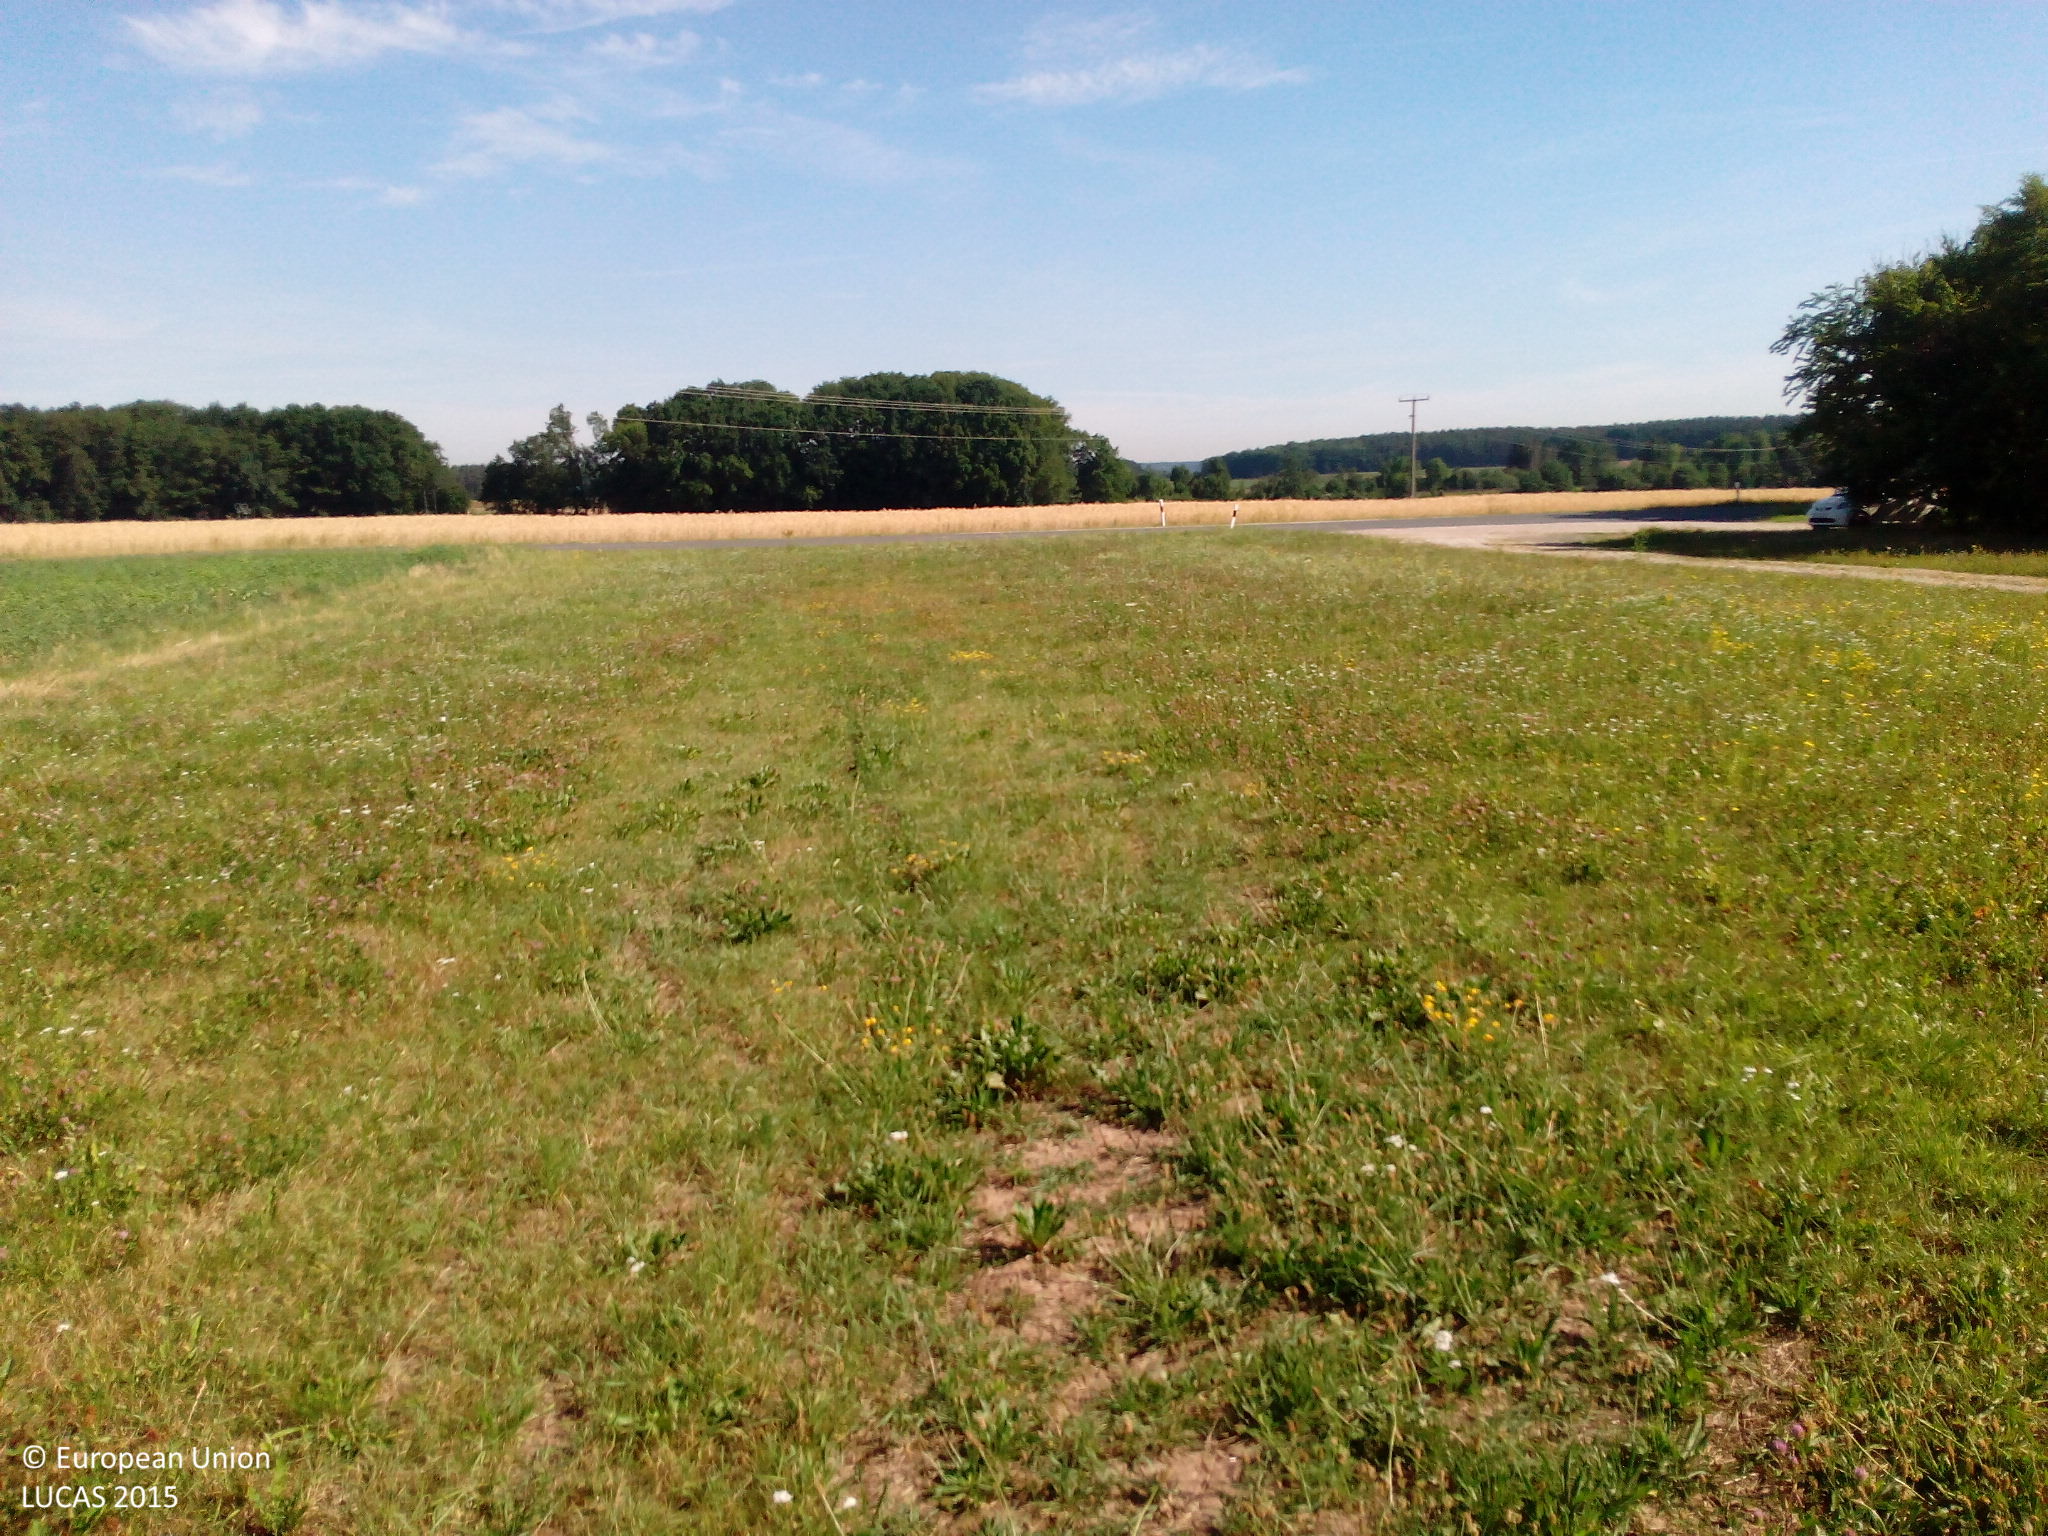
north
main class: Cropland
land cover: Apple fruit
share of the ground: < 10 %
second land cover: Grassland without tree/shrub cover
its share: > 75 %
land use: Agriculture (excluding fallow land and kitchen gardens)
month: July
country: DE
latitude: 49.4071
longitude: 10.9230
